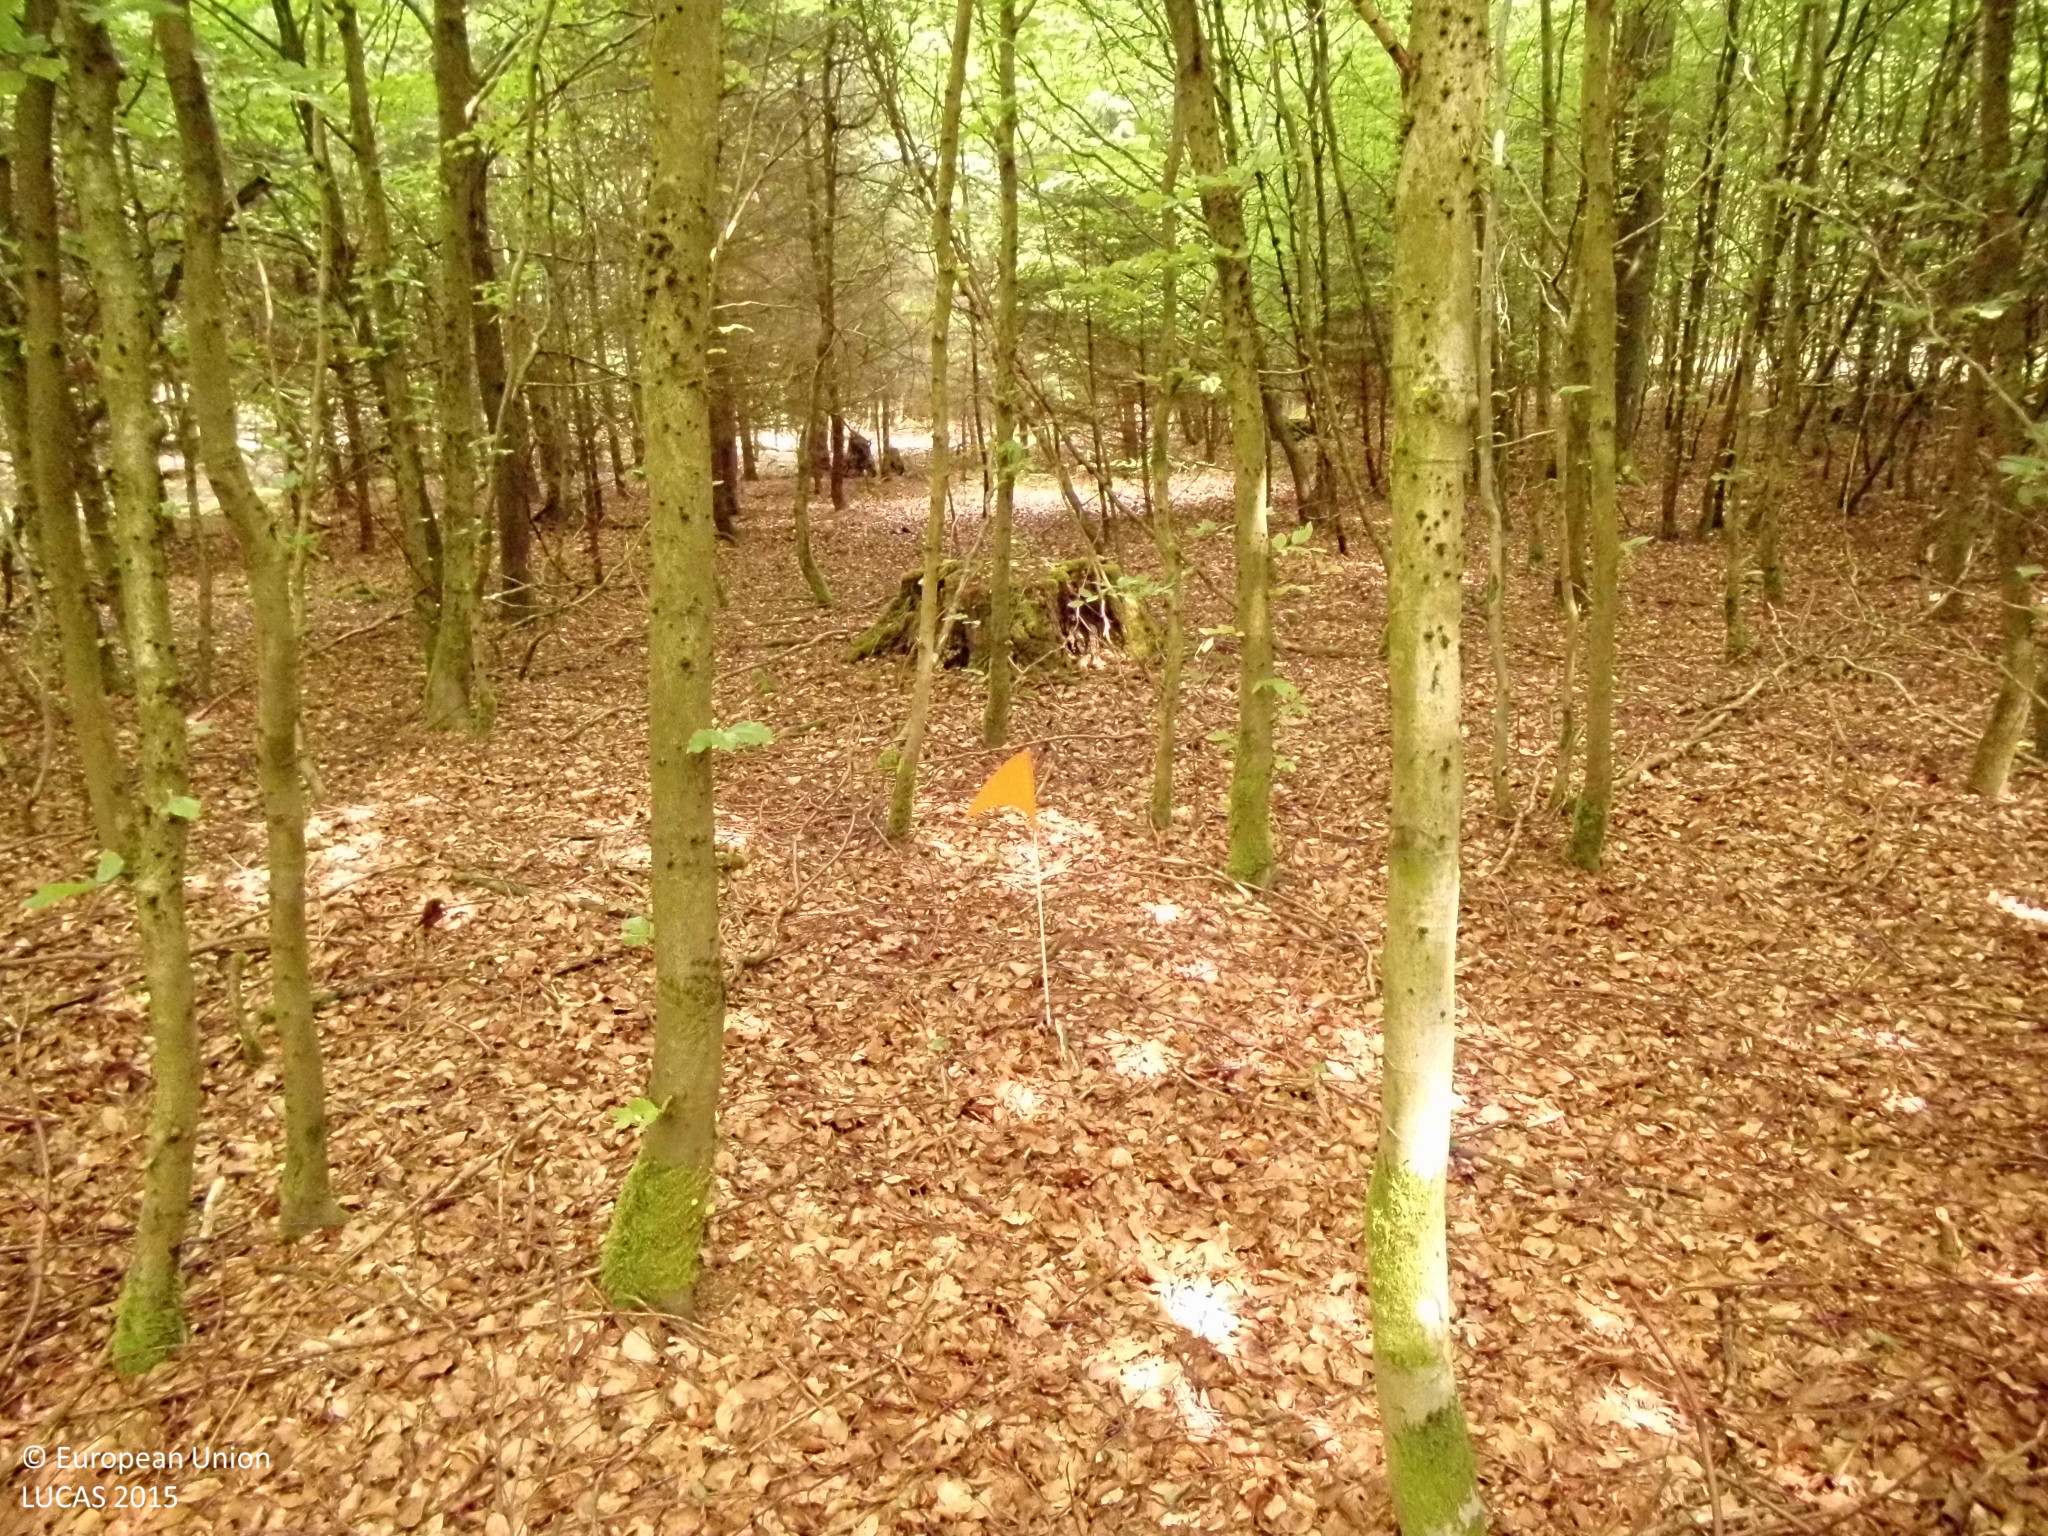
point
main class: Woodland
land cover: Spruce dominated mixed woodland
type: hemiboreal forest and nemoral coniferous forest and mixed broadleaved-coniferous forest
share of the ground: > 75 %
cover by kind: coniferous forest trees 70 %, broadleaved forest trees 30 %
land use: Forestry
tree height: > 5 m
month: May
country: DE
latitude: 50.5539
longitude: 7.5585
